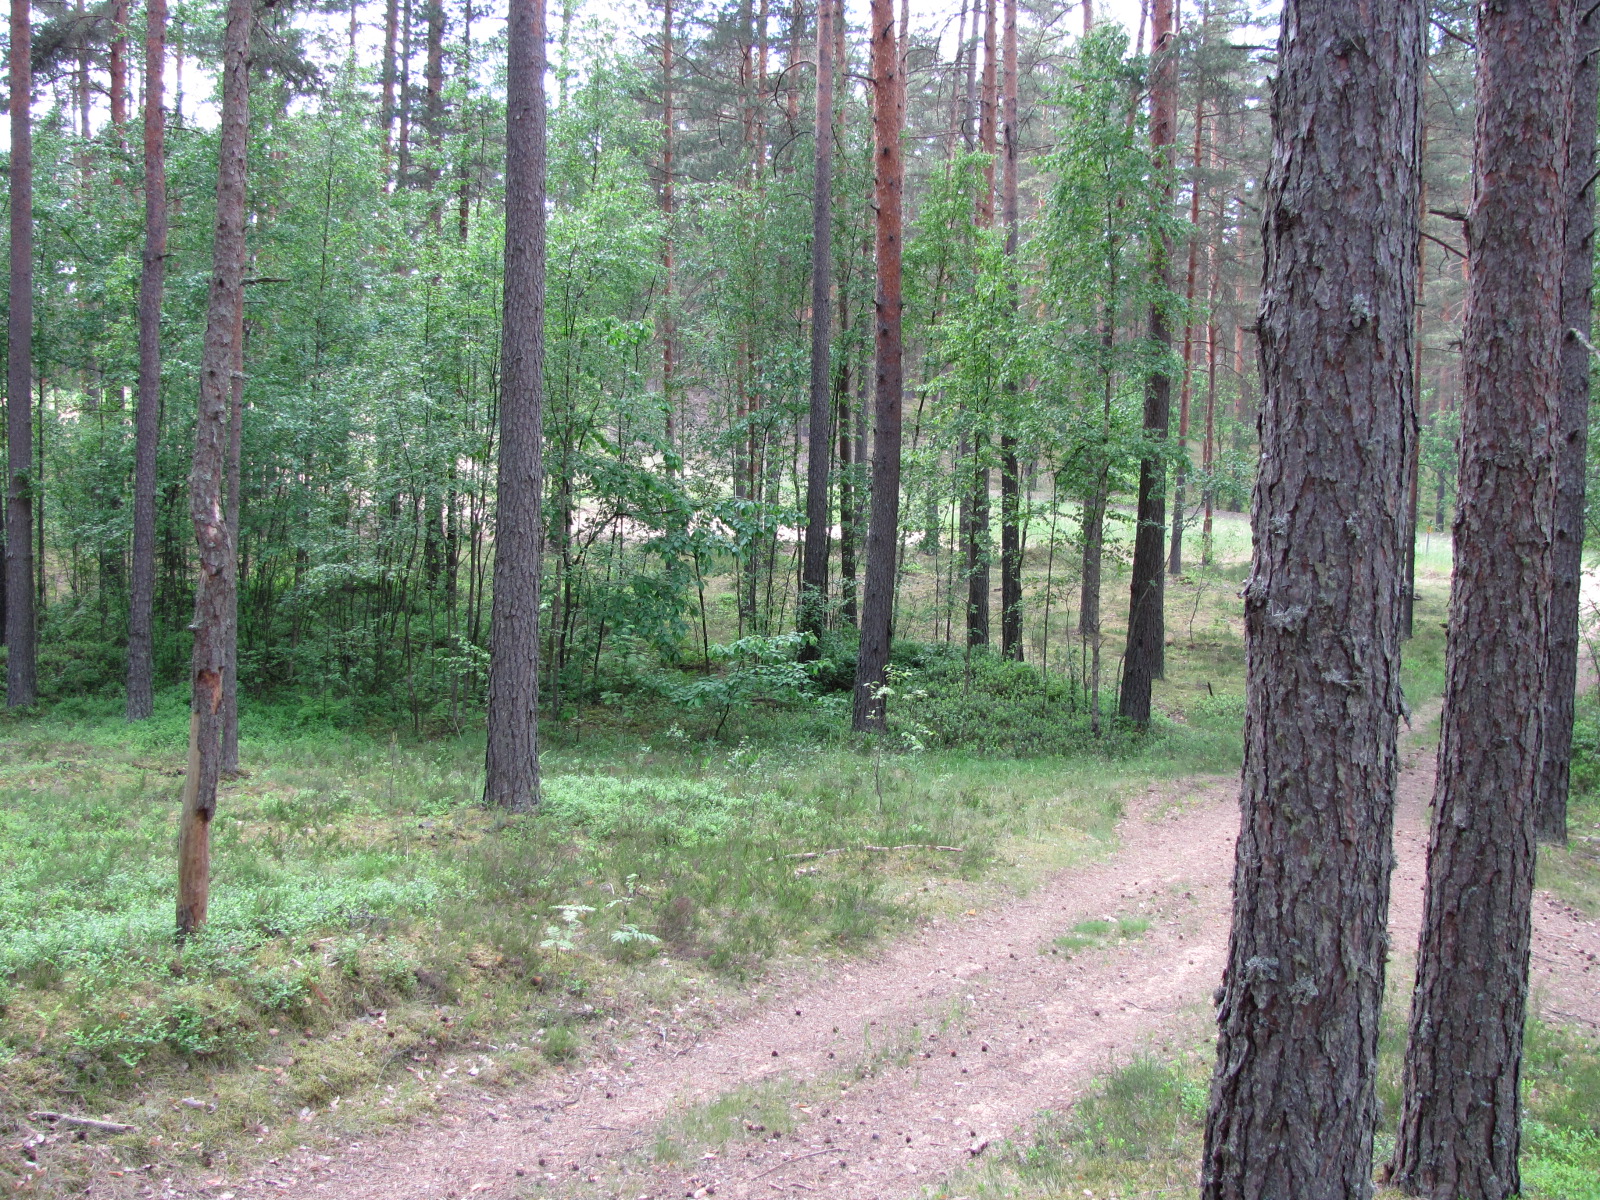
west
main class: Woodland
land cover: Pine dominated coniferous woodland
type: hemiboreal forest and nemoral coniferous forest and mixed broadleaved-coniferous forest
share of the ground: > 75 %
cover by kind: coniferous forest trees 85 %, lichens and mosses 15 %
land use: Forestry
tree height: > 5 m
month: June
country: LV
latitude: 56.9602
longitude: 24.4157
